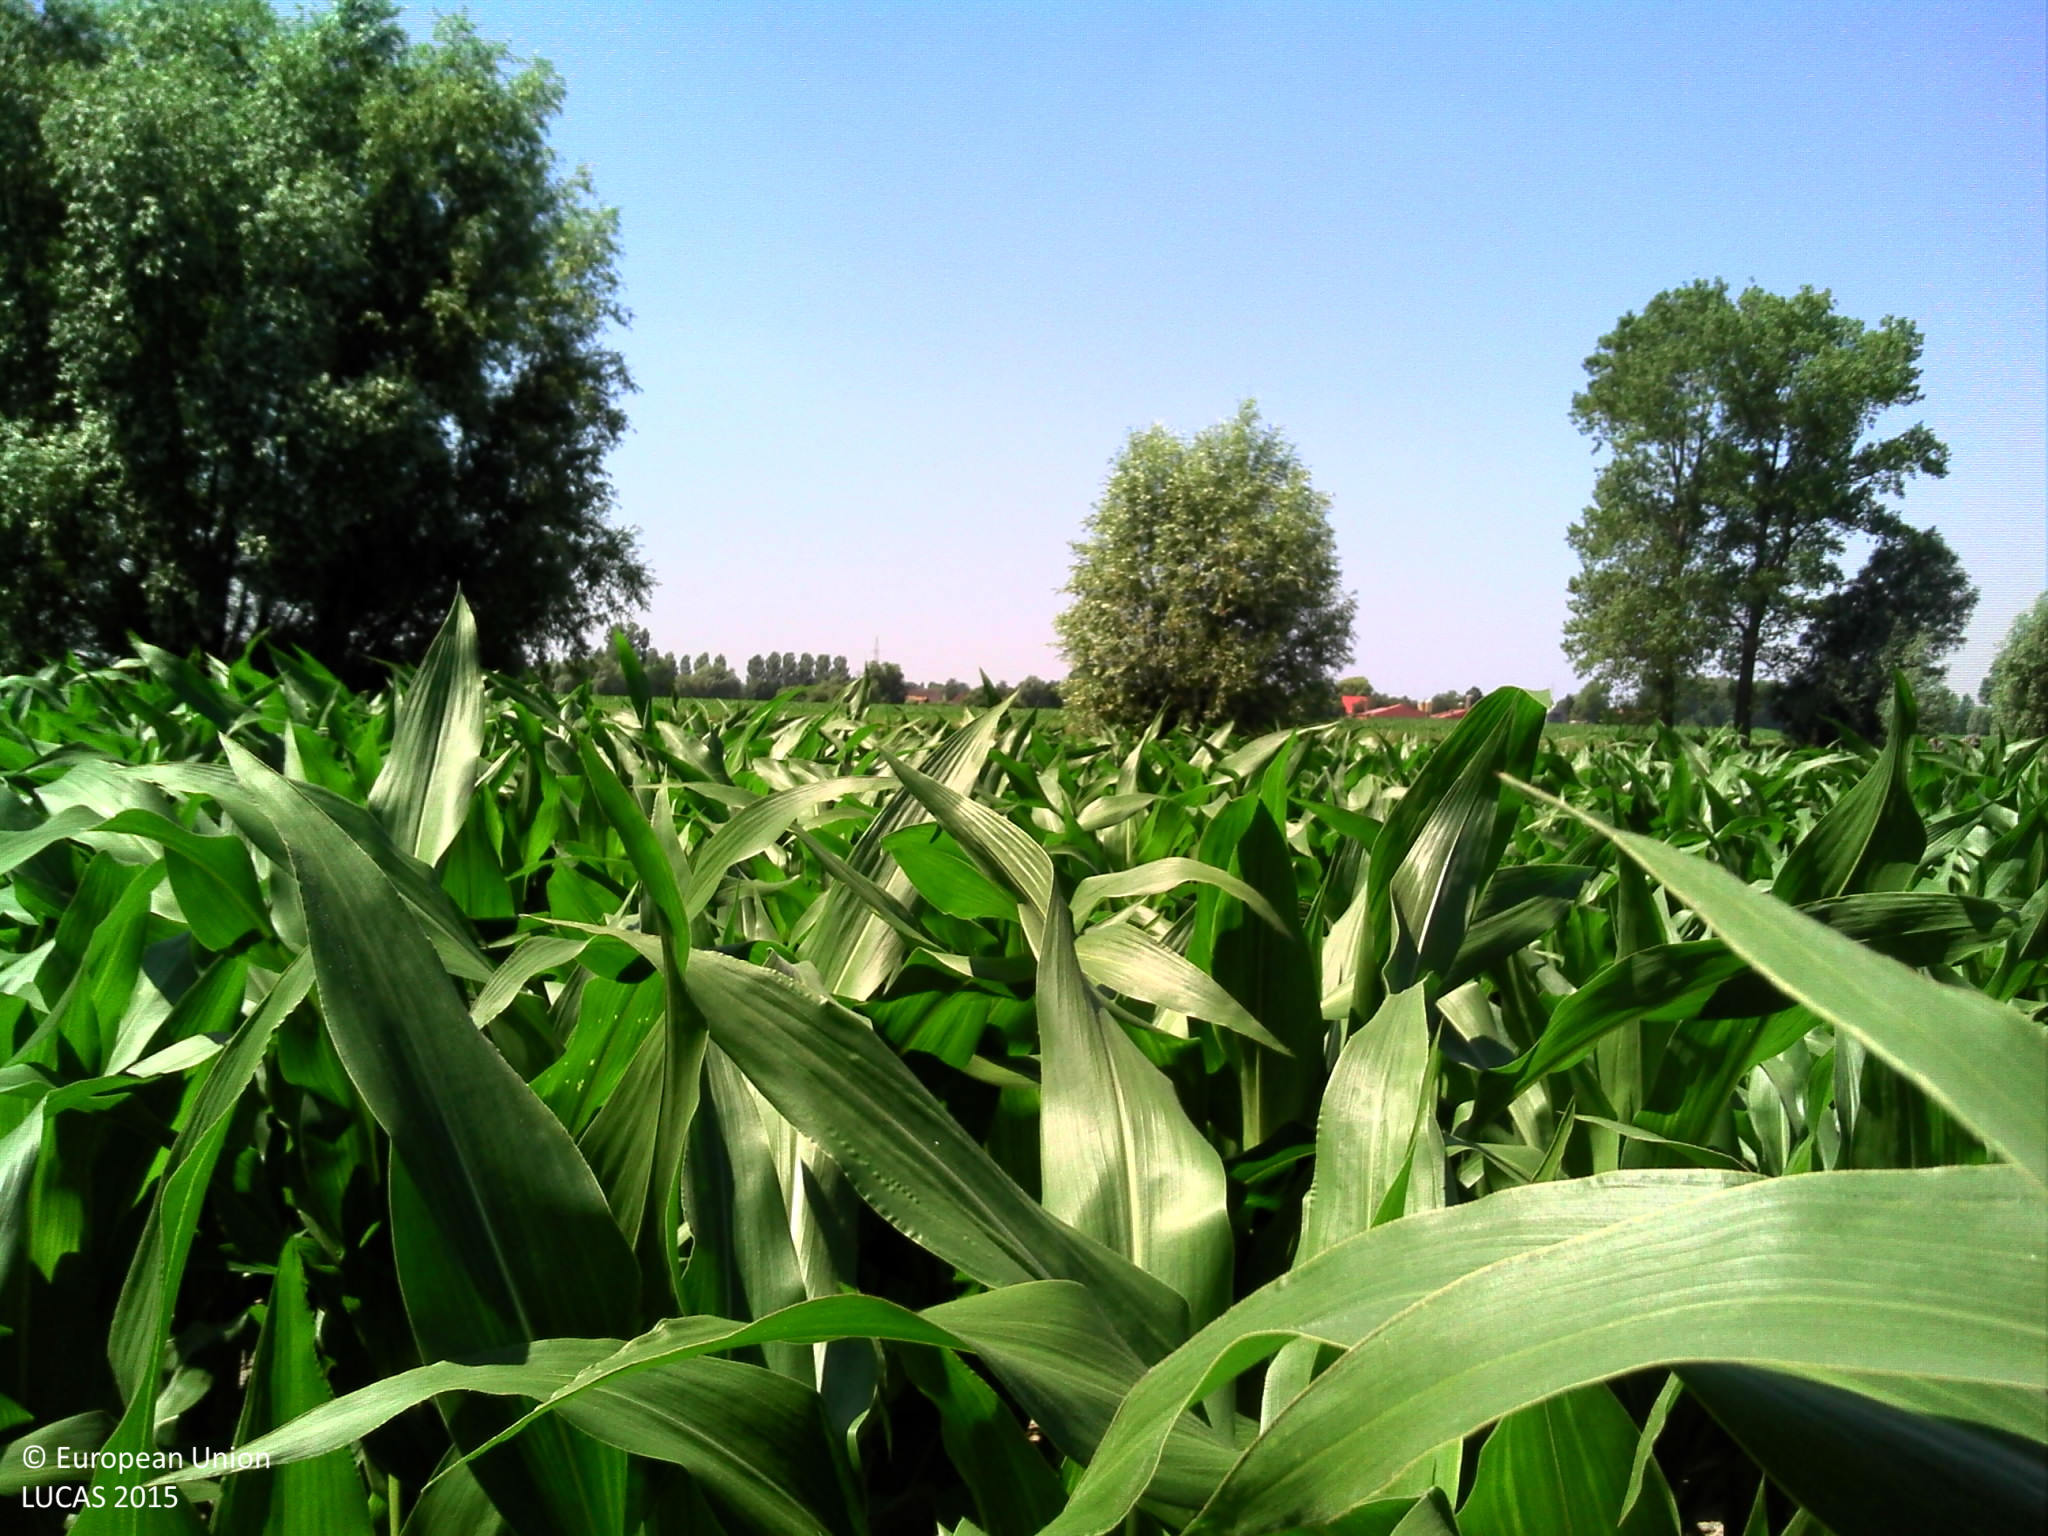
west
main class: Cropland
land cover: Maize
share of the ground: > 75 %
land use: Agriculture (excluding fallow land and kitchen gardens)
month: June
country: BE
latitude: 51.1620
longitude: 3.6581
